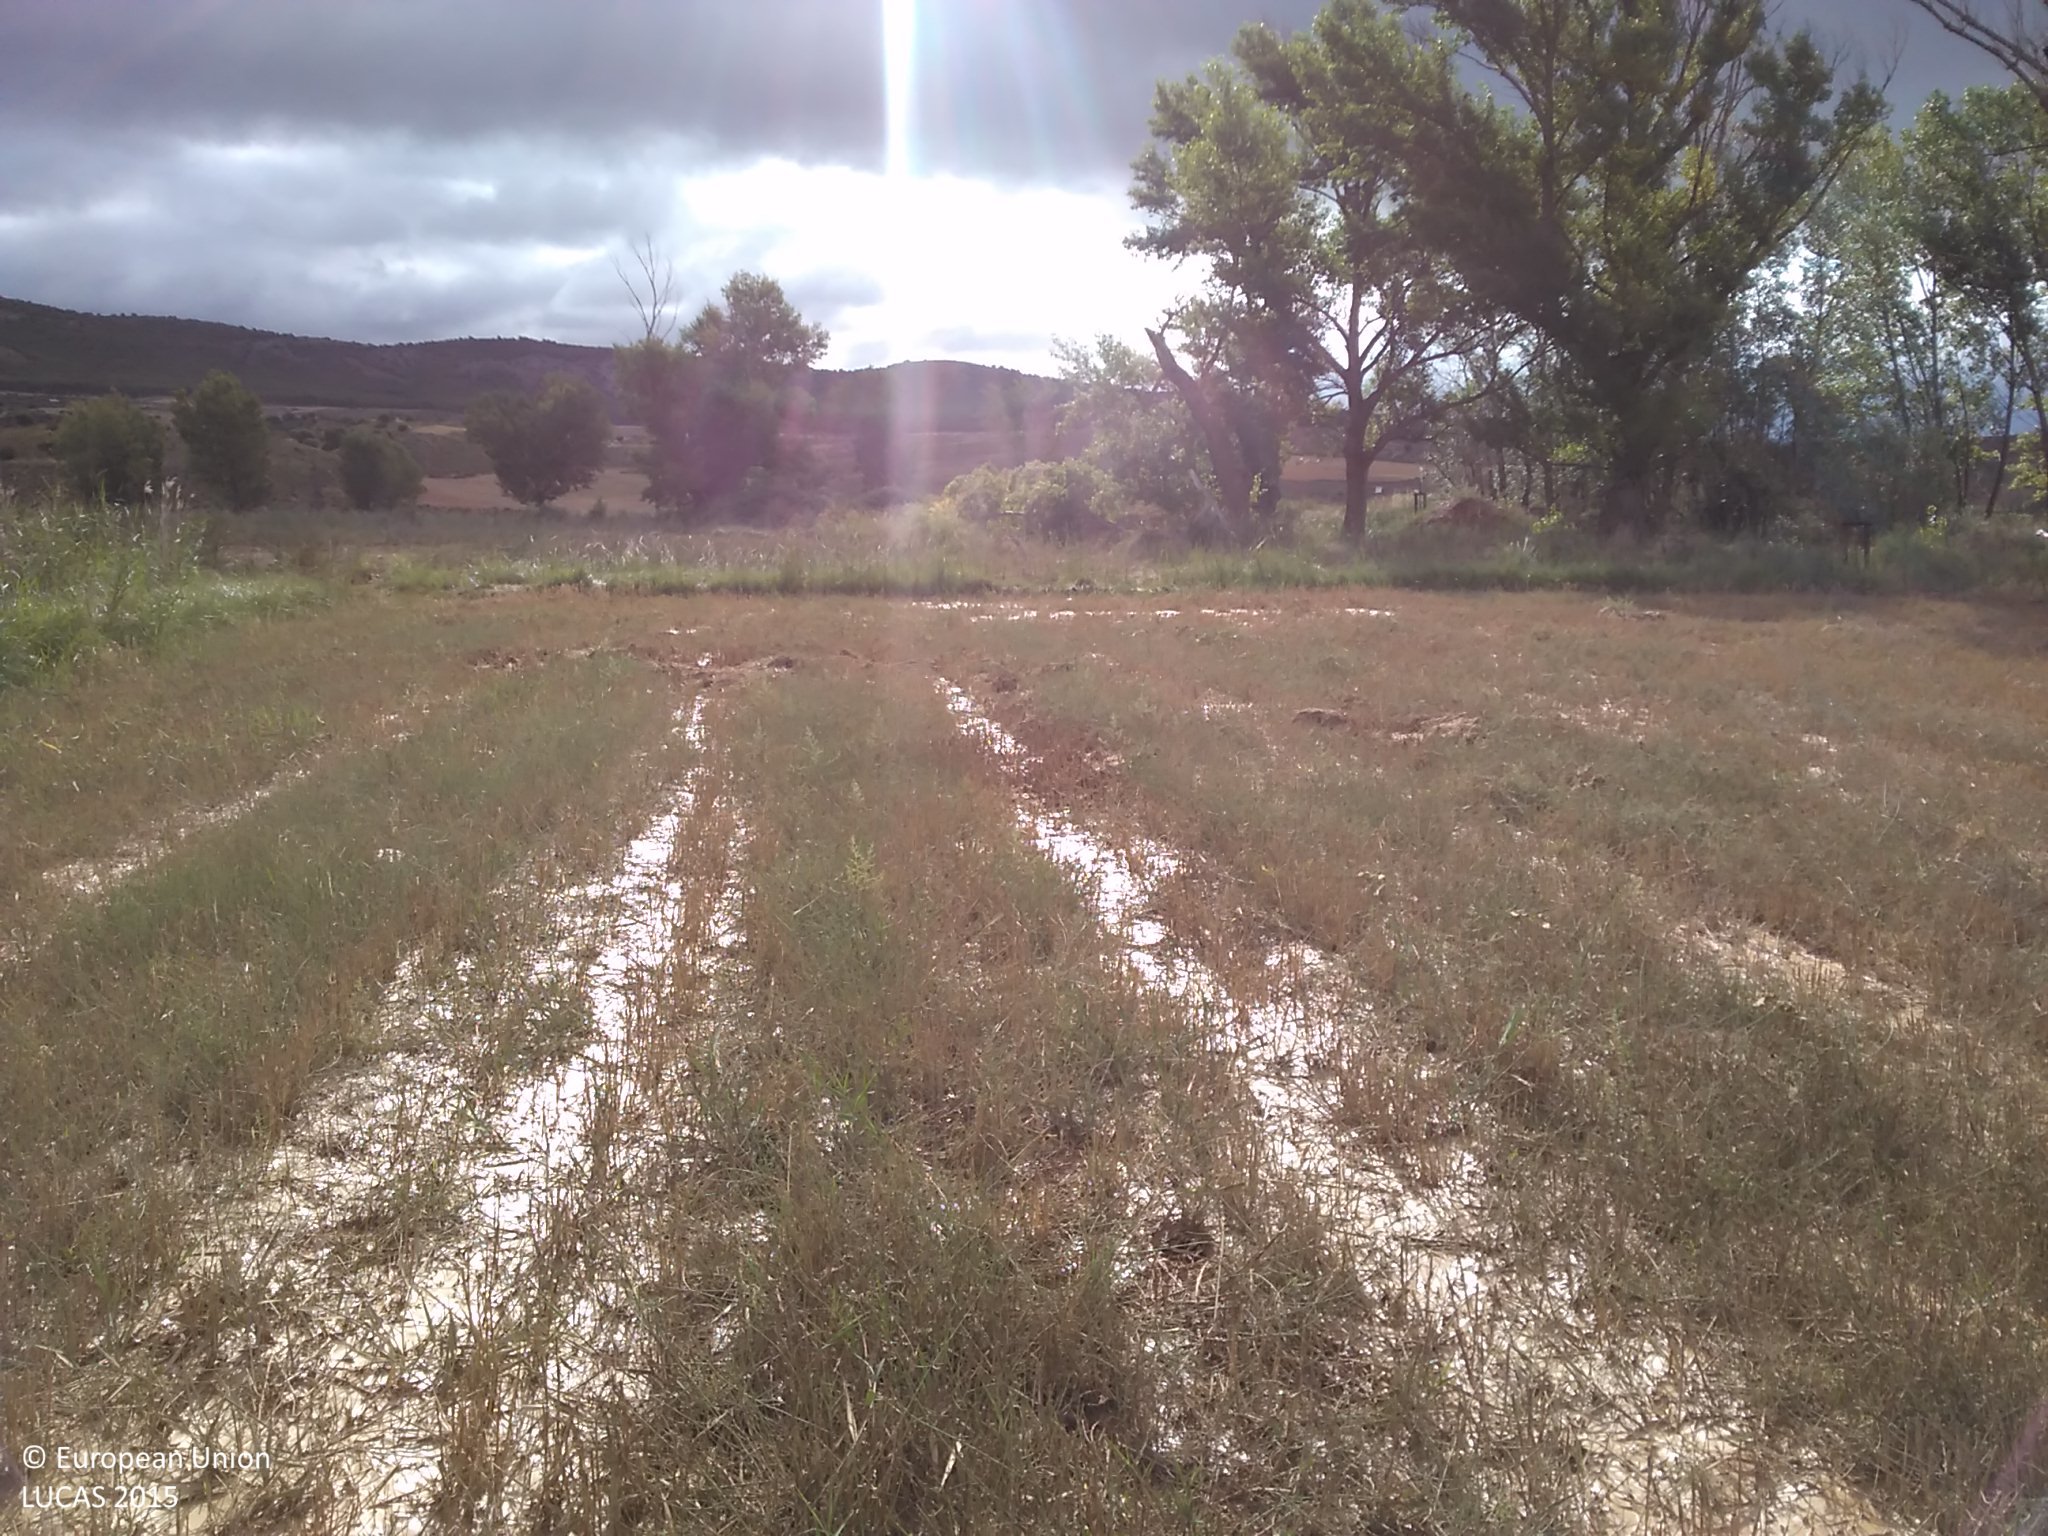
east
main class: Cropland
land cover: Barley
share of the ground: < 10 %
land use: Agriculture (excluding fallow land and kitchen gardens)
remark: Harvested field
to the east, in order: Barley; Spontaneously vegetated surfaces; Broadleaved woodland; Rivers and streams; Broadleaved woodland; Spontaneously vegetated surfaces; Arable land (only in case pi); Grass margins; Arable land (only in case pi); Single bushes/trees; Arable land (only in case pi); Spontaneously vegetated surfaces; Arable land (only in case pi)
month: July
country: ES
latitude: 41.3399
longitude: -1.9663
